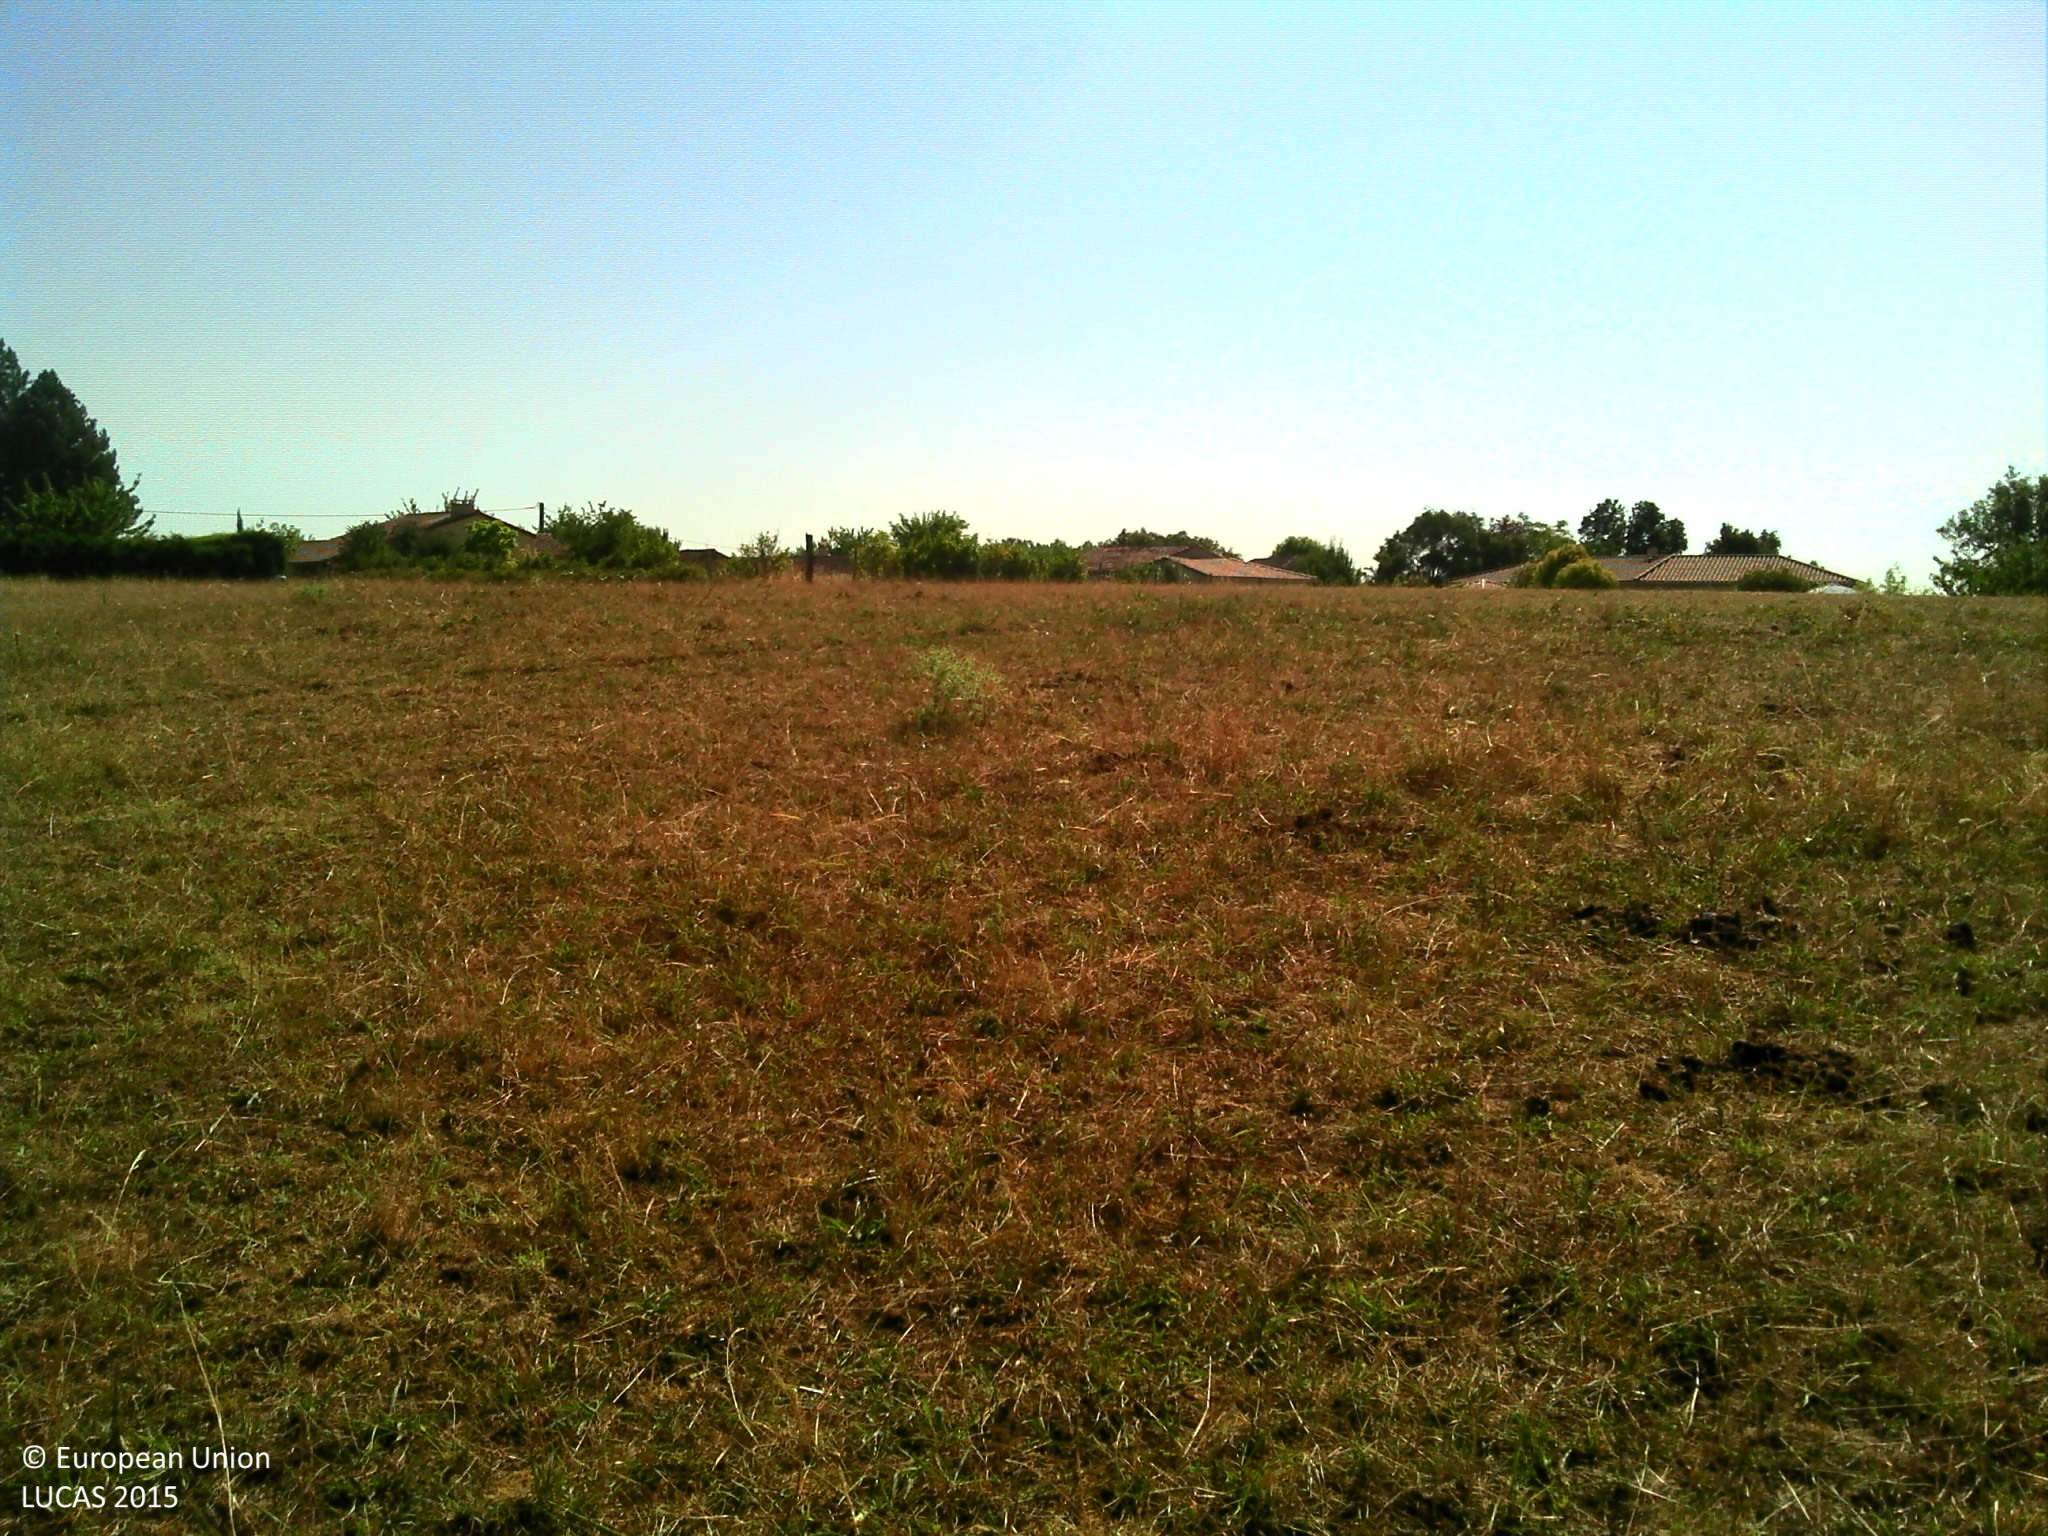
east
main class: Grassland
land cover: Grassland without tree/shrub cover
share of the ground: > 75 %
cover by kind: herbaceous plants 100 %
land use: Agriculture (excluding fallow land and kitchen gardens)
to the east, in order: Grassland without tree/shrub cover; Artificial constructions in urban areas; Shrubland with sparse tree cover; Sunflower
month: July
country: FR
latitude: 44.6487
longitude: 0.5983
